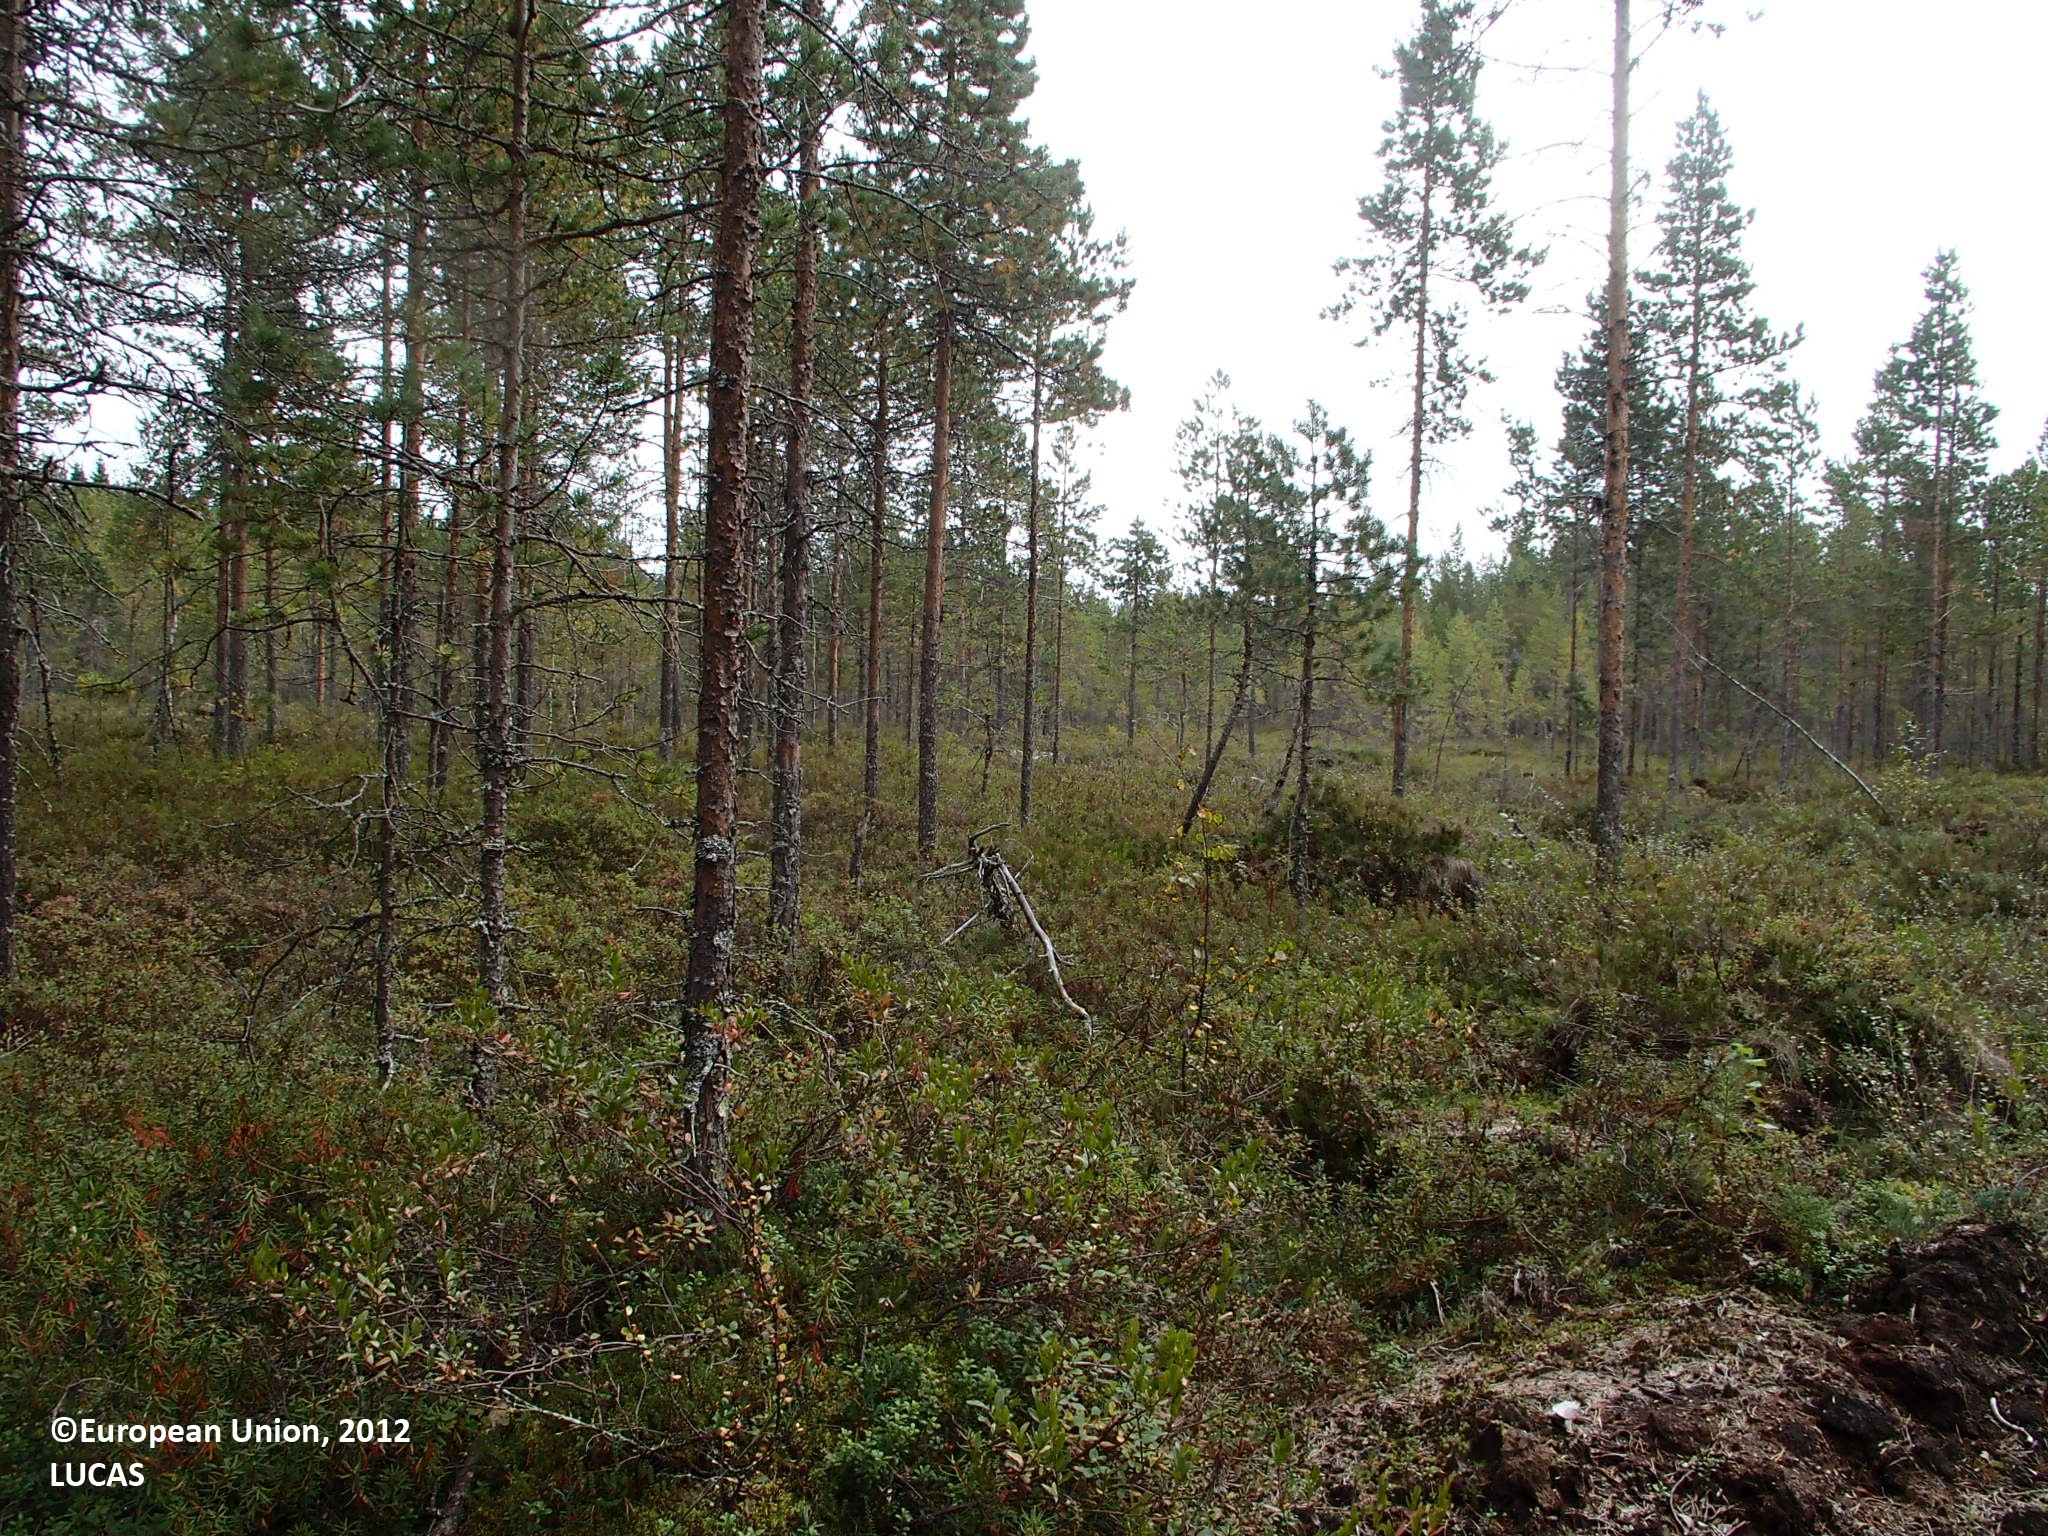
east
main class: Woodland
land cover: Pine dominated coniferous woodland
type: boreal forest
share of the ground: 50 - 75 %
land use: Forestry
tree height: > 5 m
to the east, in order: Pine dominated coniferous woodland; Ditches and canals; Pine dominated coniferous woodland; Ditches and canals; Pine dominated coniferous woodland; Ditches and canals; Pine dominated coniferous woodland; Other mixed woodland; Ditches and canals; Paved roads, cycling and walking lanes; Abandoned hedges; Ditches and canals
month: September
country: FI
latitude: 63.7998
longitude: 26.0058
